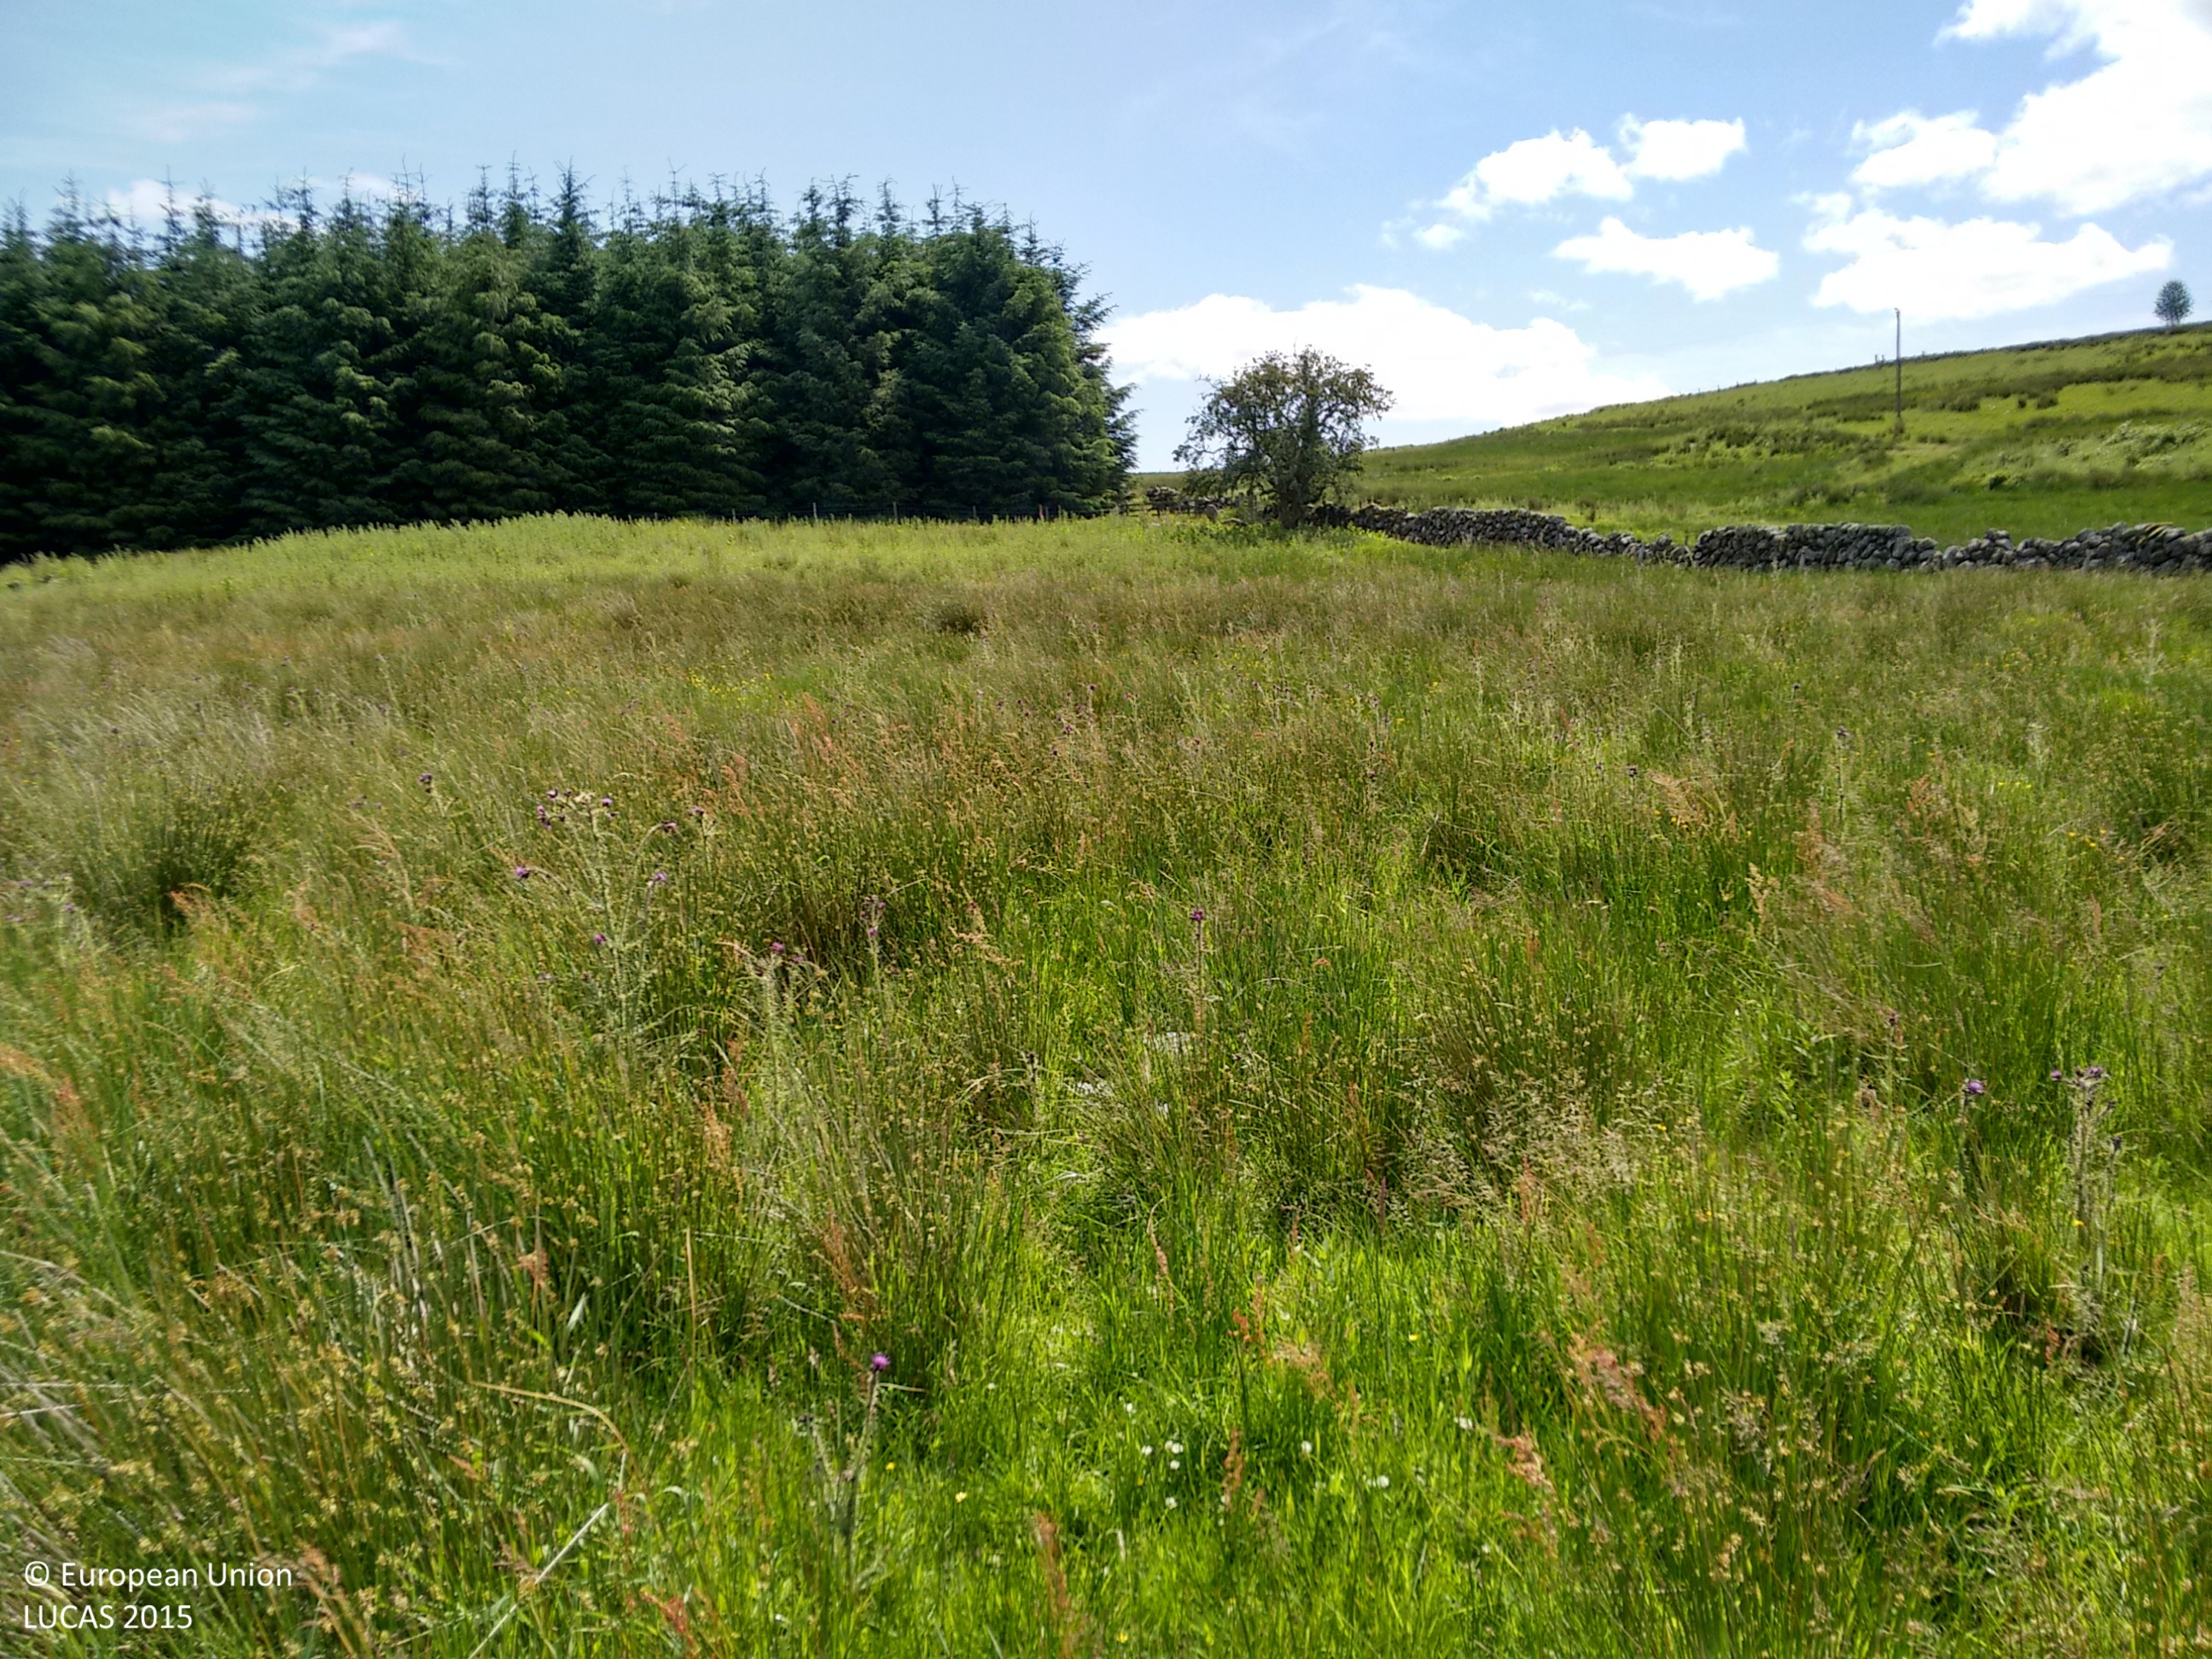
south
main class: Grassland
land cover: Grassland without tree/shrub cover
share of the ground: > 75 %
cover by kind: herbaceous plants 100 %
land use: Agriculture (excluding fallow land and kitchen gardens)
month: July
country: GB
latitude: 55.1157
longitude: -4.2212
